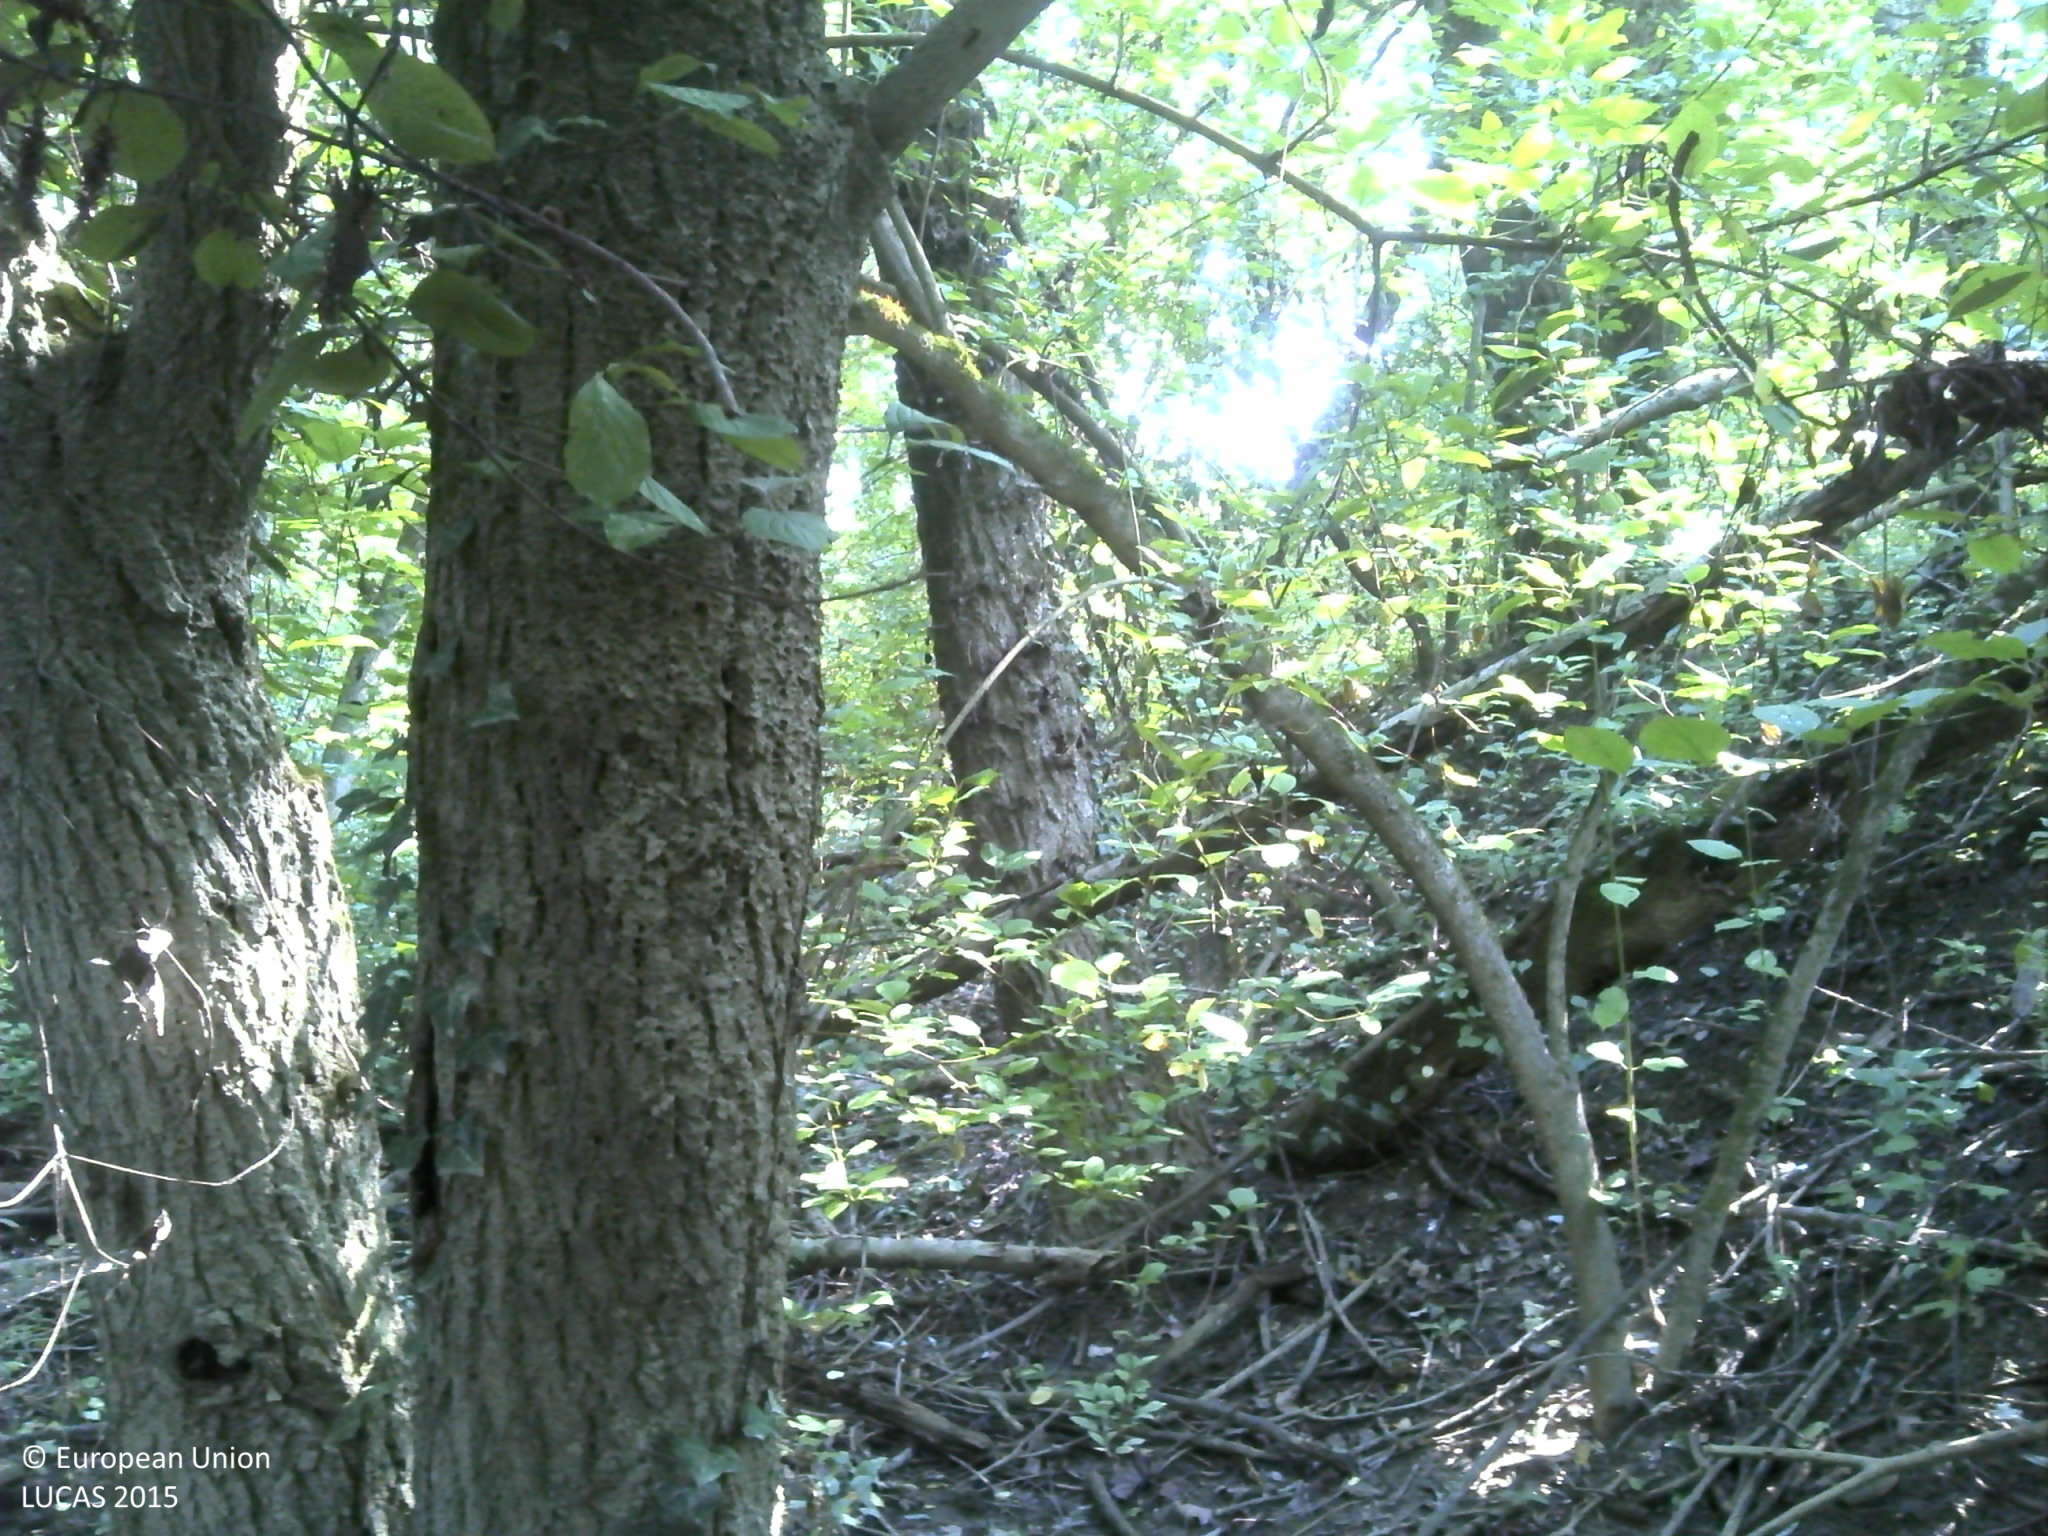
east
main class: Woodland
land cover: Broadleaved woodland
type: mesophytic deciduous forest
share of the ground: > 75 %
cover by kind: broadleaved forest trees 100 %
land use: Forestry
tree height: > 5 m
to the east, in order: Broadleaved woodland; Shrubland with sparse tree cover; Rivers and streams; Shrubland with sparse tree cover
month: September
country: HR
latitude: 45.6206
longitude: 16.3466
